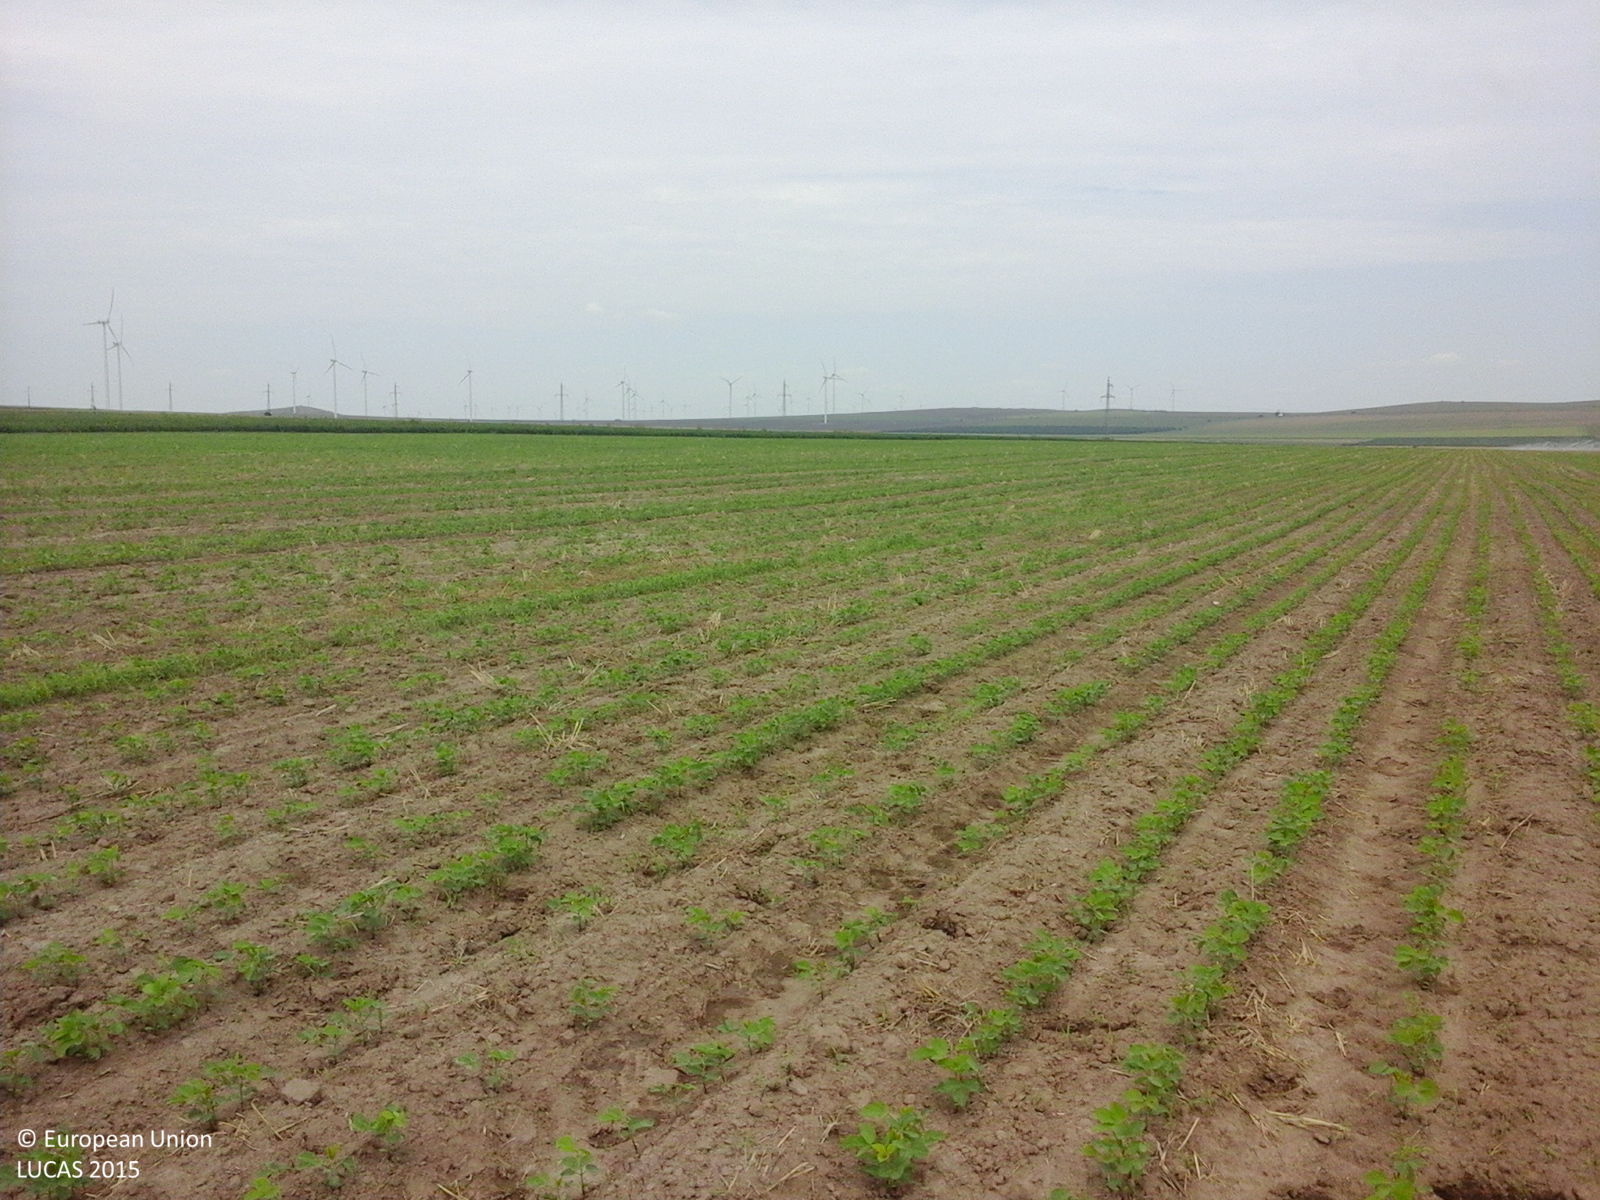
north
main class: Cropland
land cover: Soya
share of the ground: 10 - 25 %
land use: Agriculture (excluding fallow land and kitchen gardens)
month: August
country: RO
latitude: 45.0349
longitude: 28.9961
